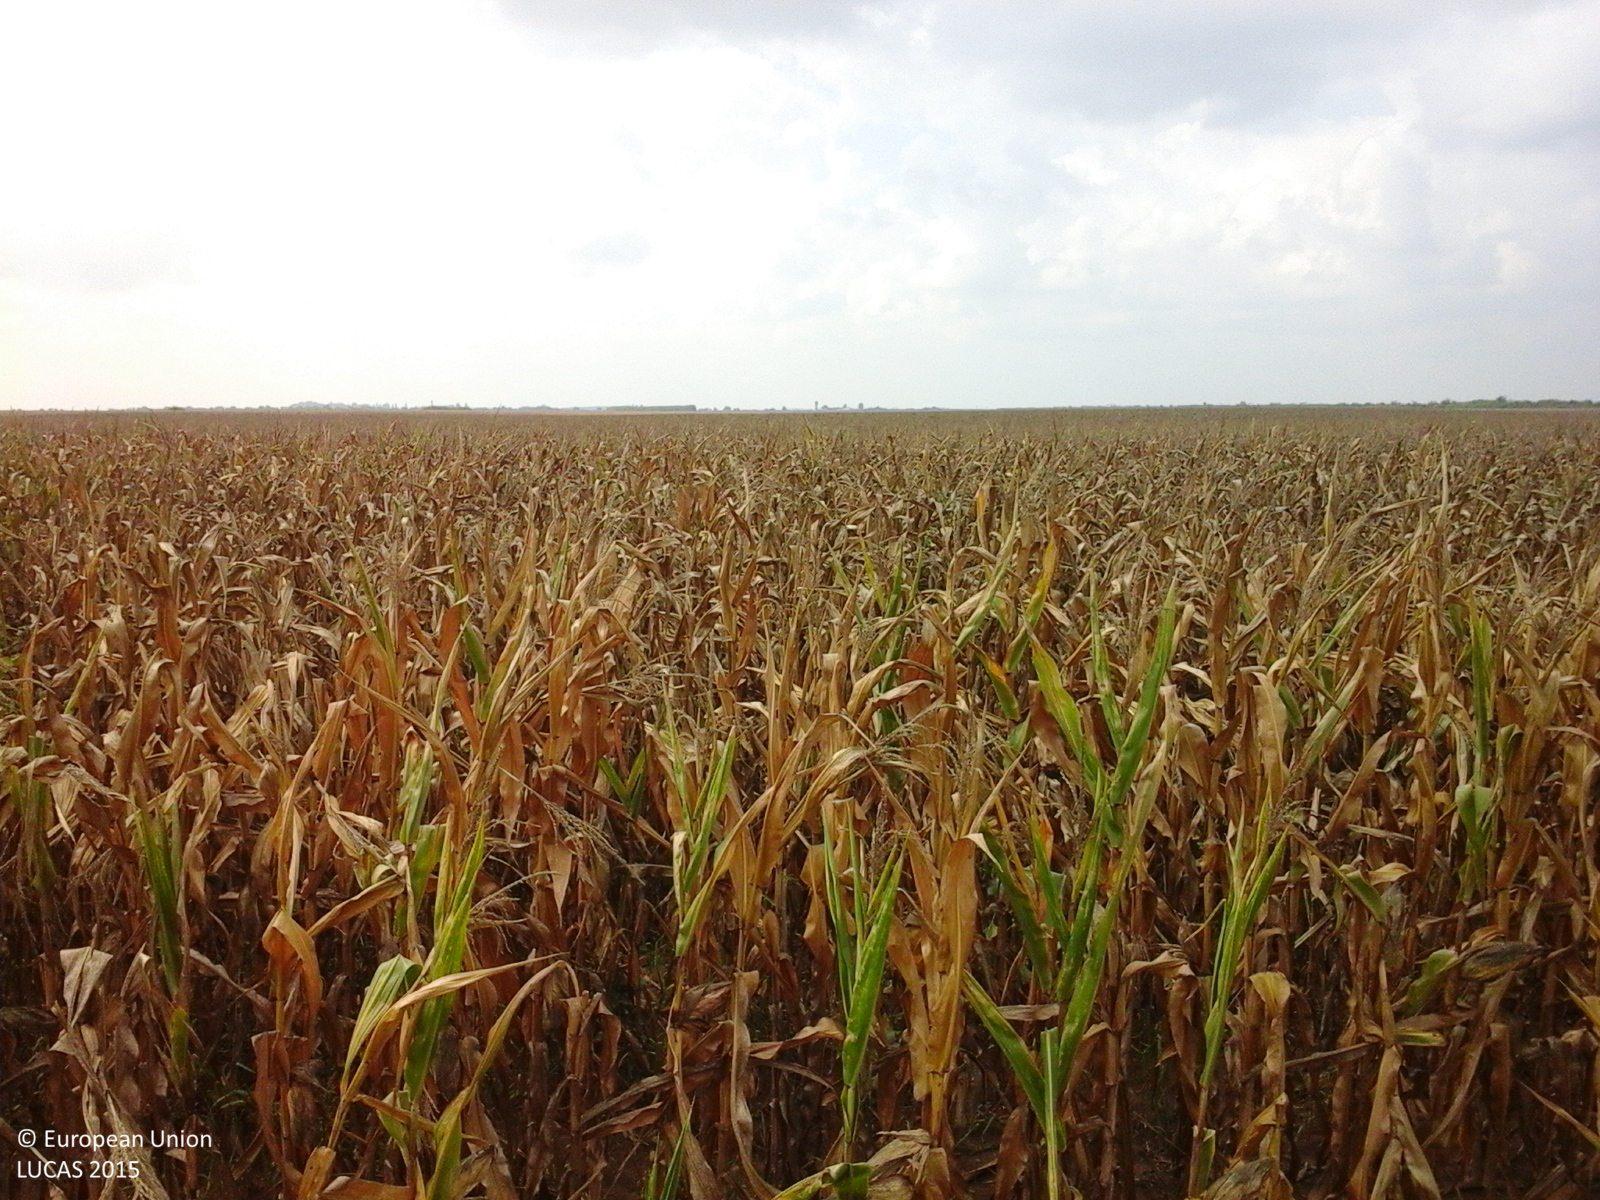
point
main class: Cropland
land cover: Maize
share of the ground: > 75 %
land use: Agriculture (excluding fallow land and kitchen gardens)
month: September
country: RO
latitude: 46.7317
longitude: 21.8072
